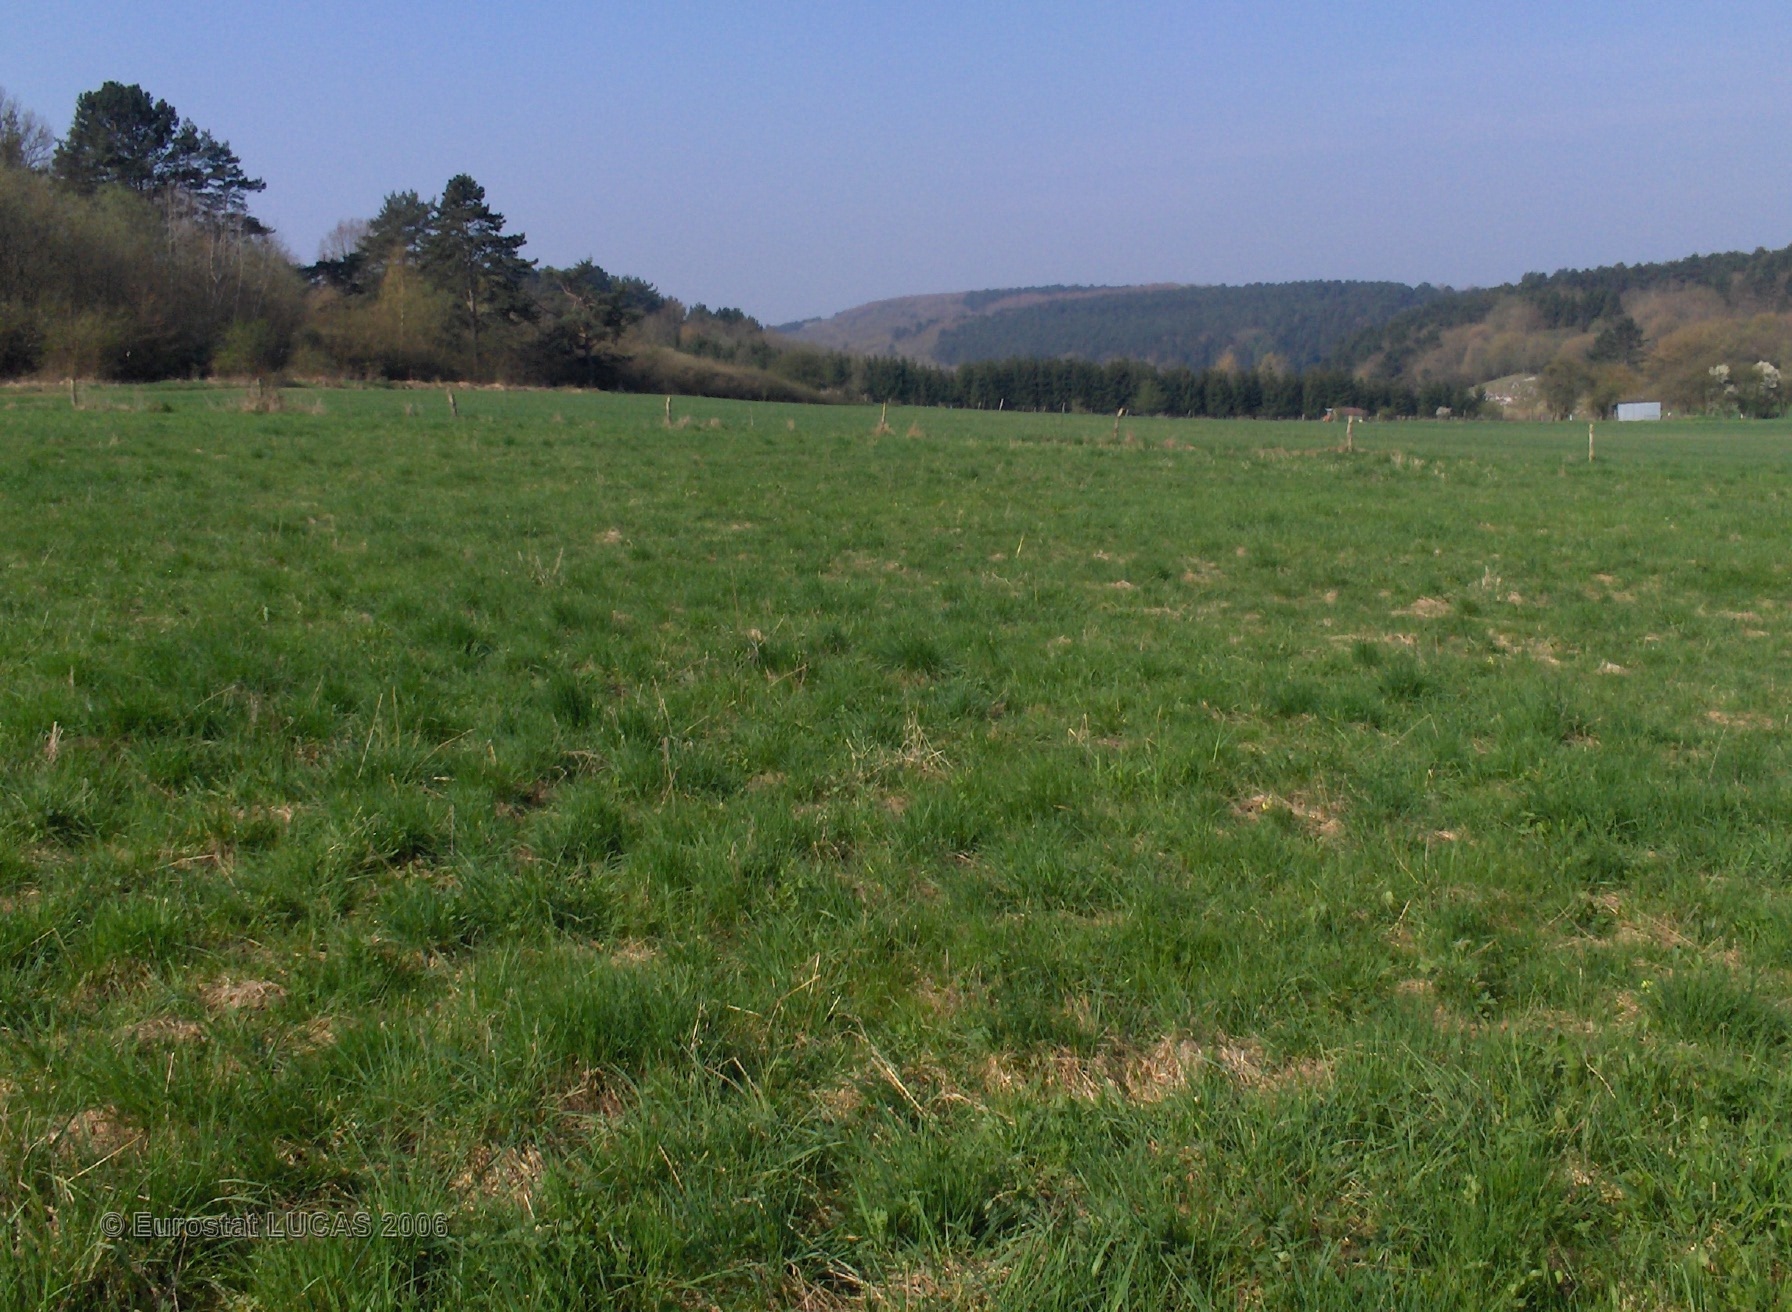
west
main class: Grassland
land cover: Grassland without tree/shrub cover
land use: Agriculture (excluding fallow land and kitchen gardens)
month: April
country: BE
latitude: 50.0725
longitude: 4.5610
